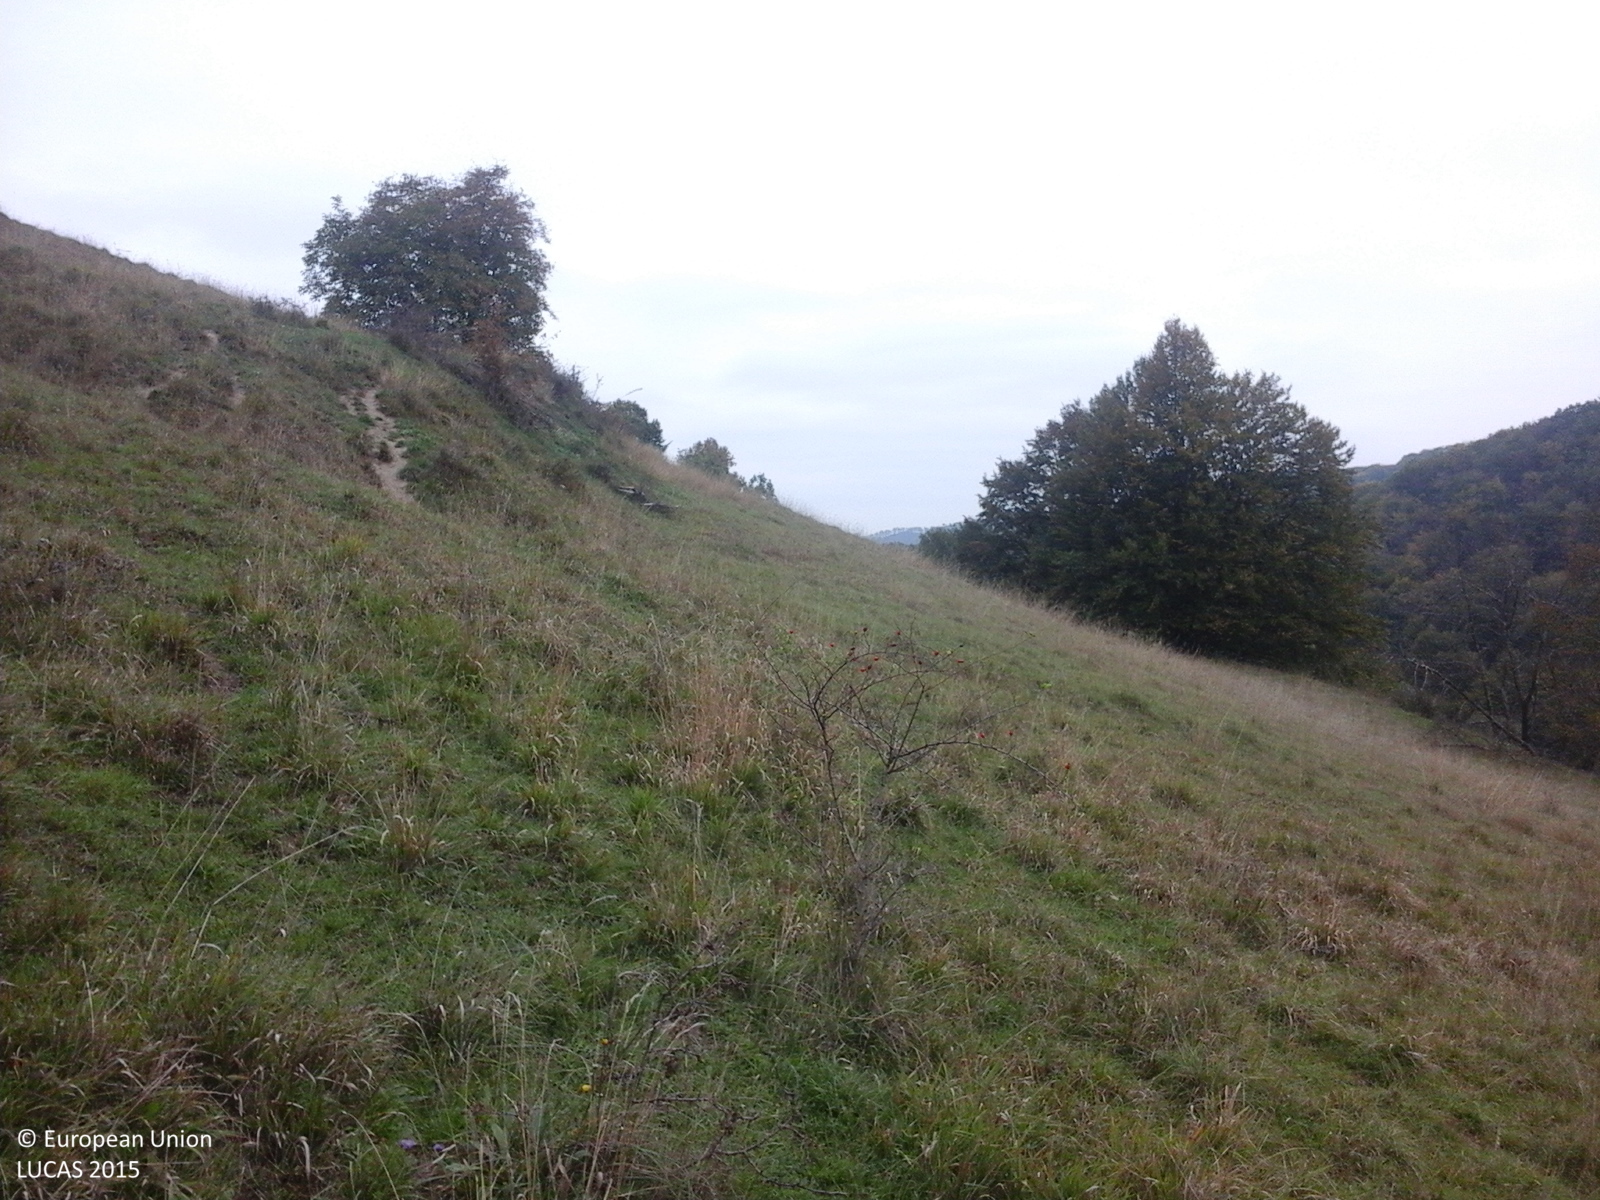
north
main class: Grassland
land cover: Grassland with sparse tree/shrub cover
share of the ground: > 75 %
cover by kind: herbaceous plants 85 %, shrubs 10 %, broadleaved forest trees 5 %
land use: Agriculture (excluding fallow land and kitchen gardens)
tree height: < 5 m
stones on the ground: < 10 %
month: October
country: RO
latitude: 46.0983
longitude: 24.6919
